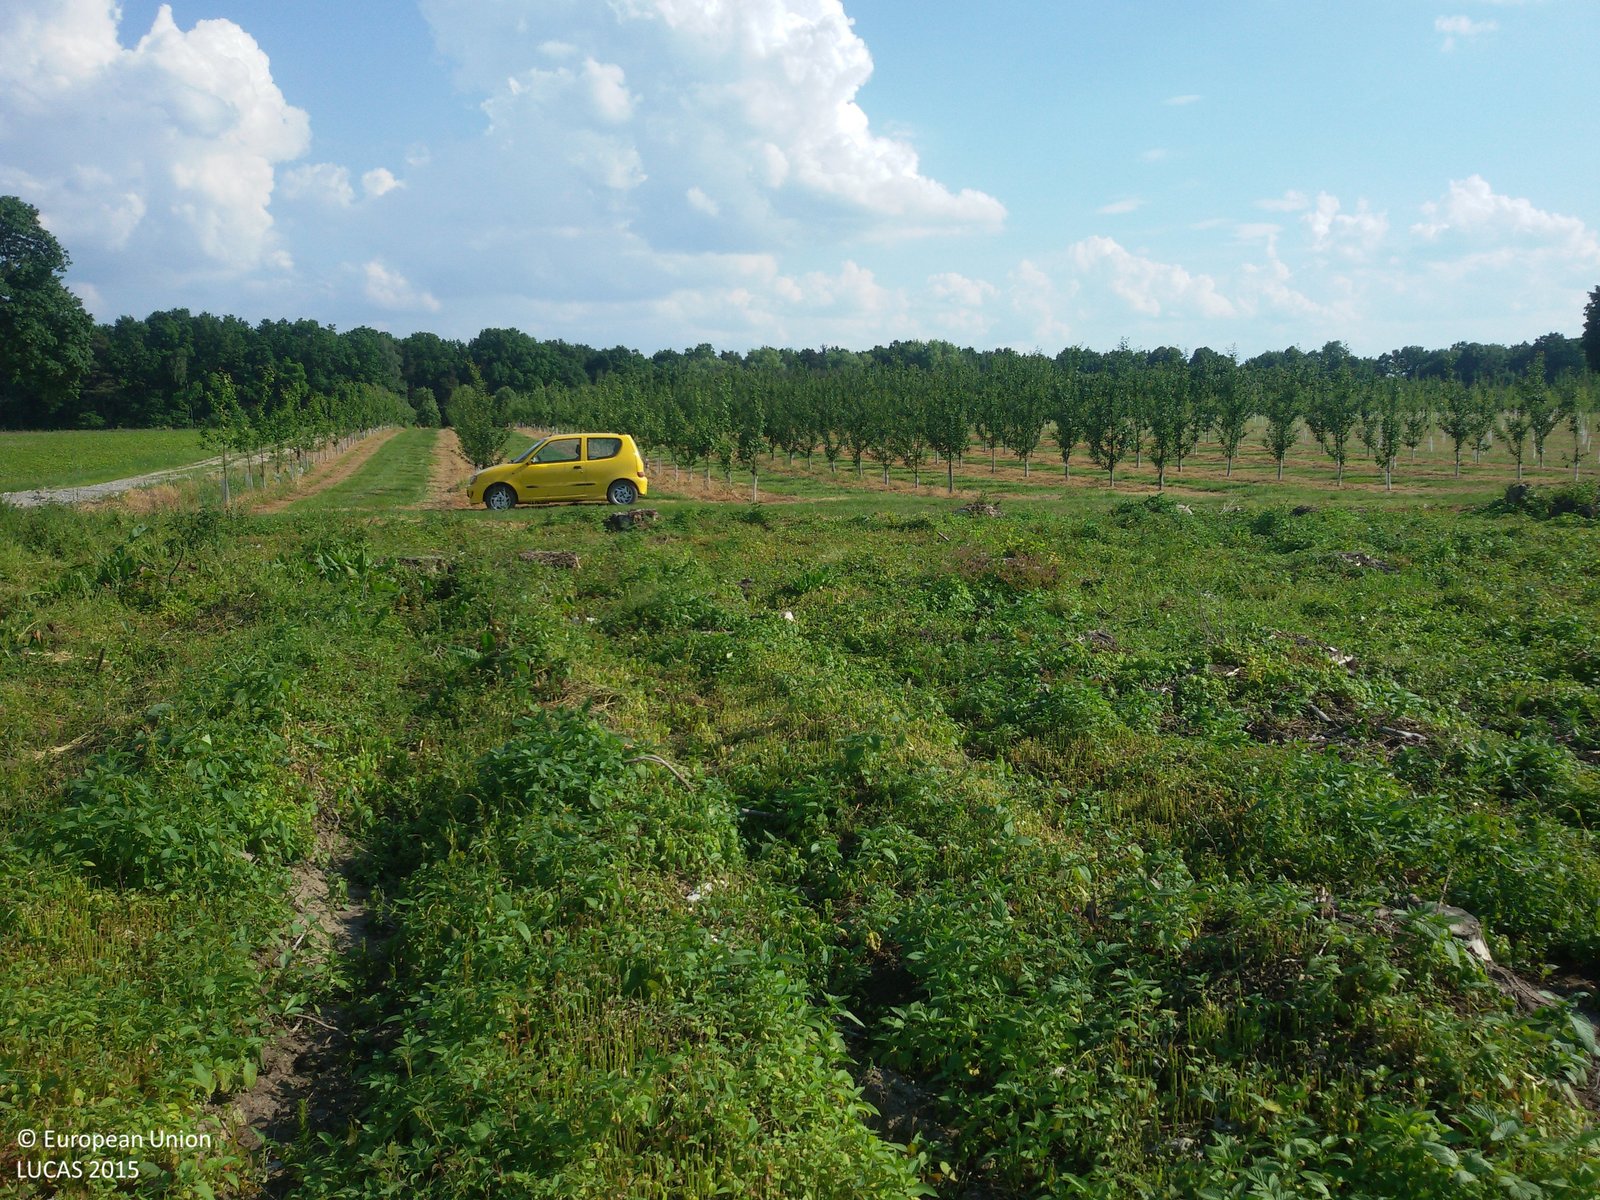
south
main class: Grassland
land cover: Spontaneously vegetated surfaces
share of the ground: > 75 %
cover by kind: herbaceous plants 95 %
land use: Forestry
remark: Clear cut
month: June
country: PL
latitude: 51.6242
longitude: 20.6572
